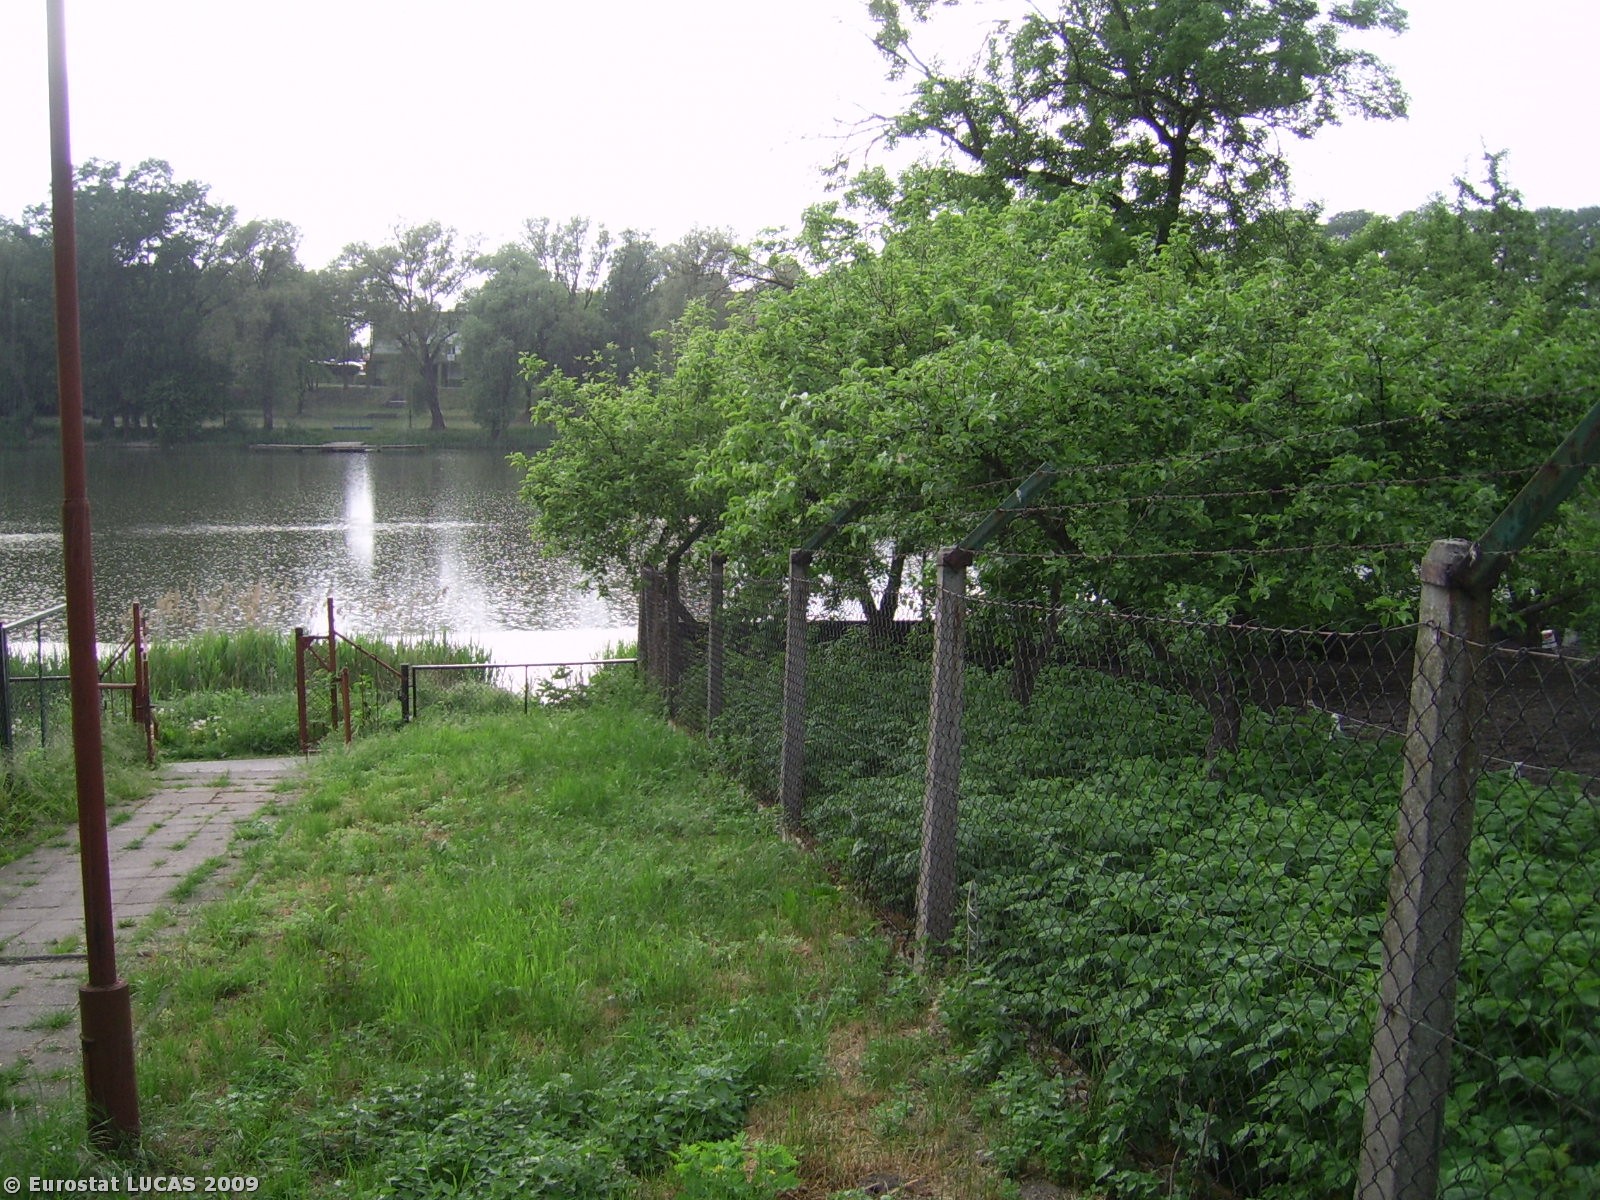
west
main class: Grassland
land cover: Grassland without tree/shrub cover
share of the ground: 50 - 75 %
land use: Residential
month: May
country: PL
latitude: 52.6524
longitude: 17.9531
